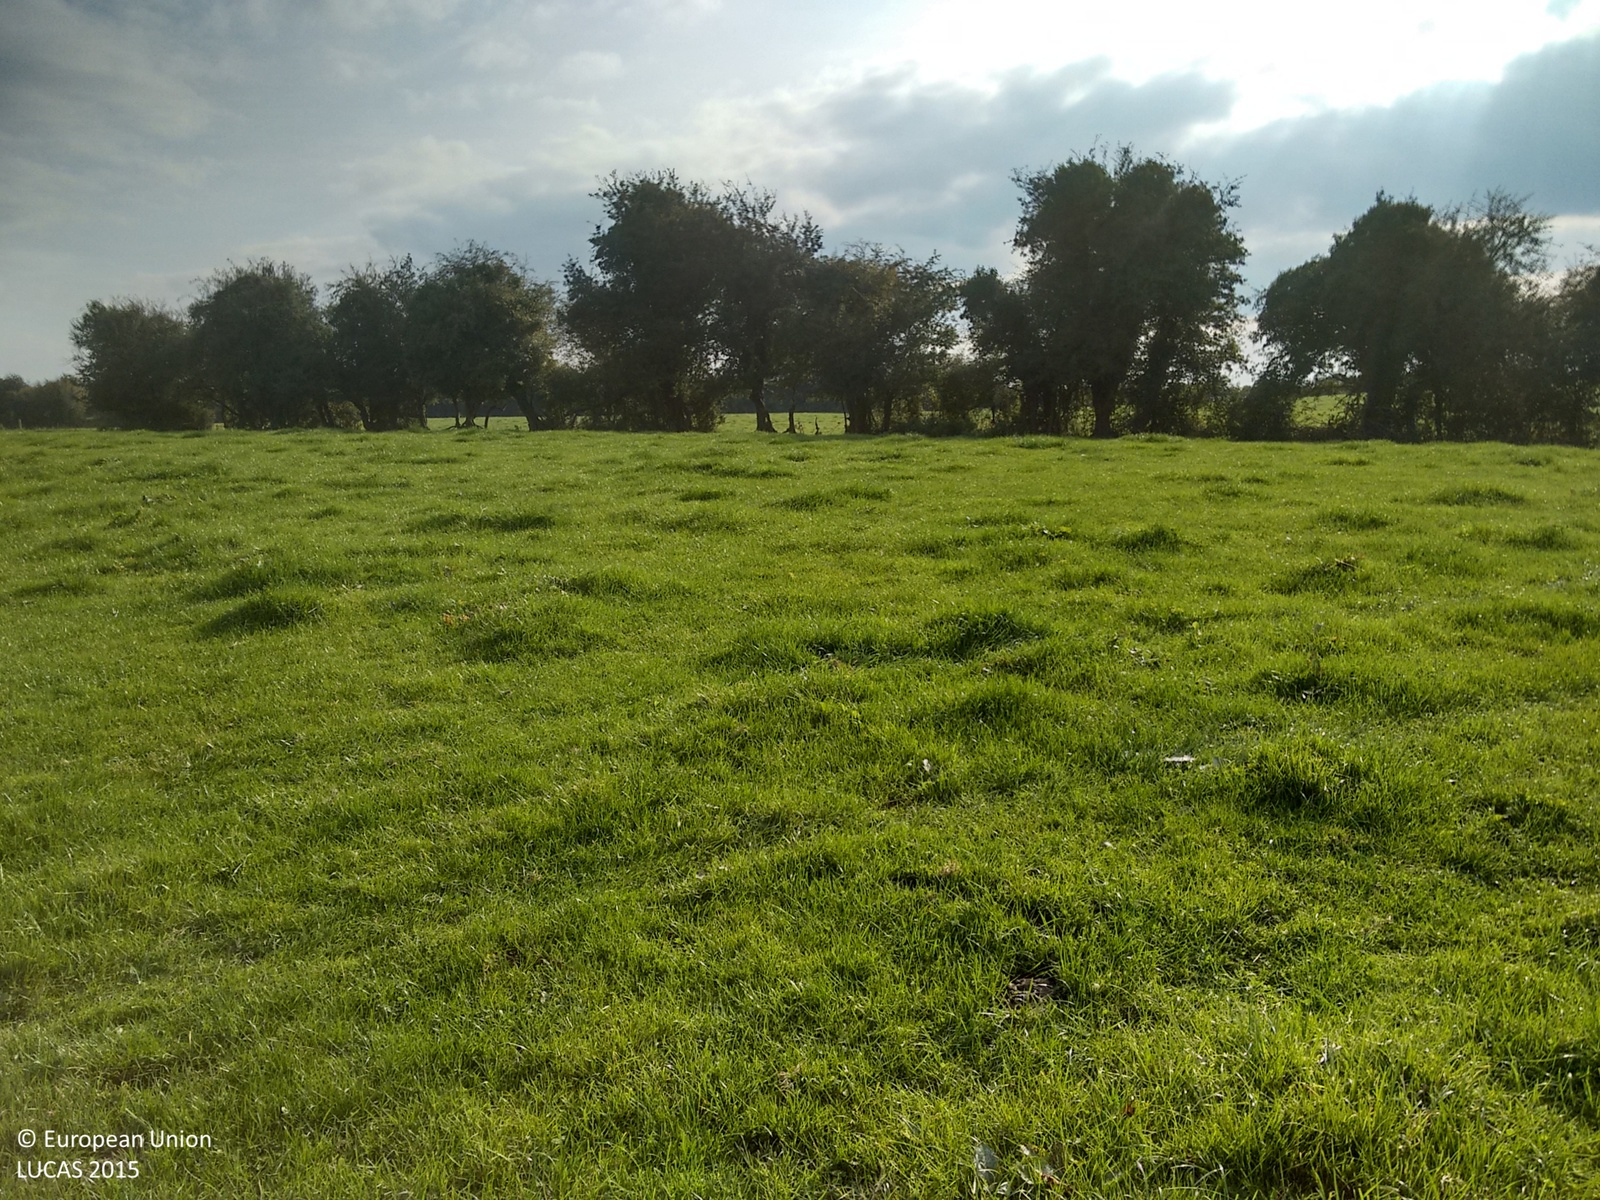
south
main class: Grassland
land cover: Grassland without tree/shrub cover
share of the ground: > 75 %
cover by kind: herbaceous plants 100 %
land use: Agriculture (excluding fallow land and kitchen gardens)
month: October
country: IE
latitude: 52.8690
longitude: -7.6180
